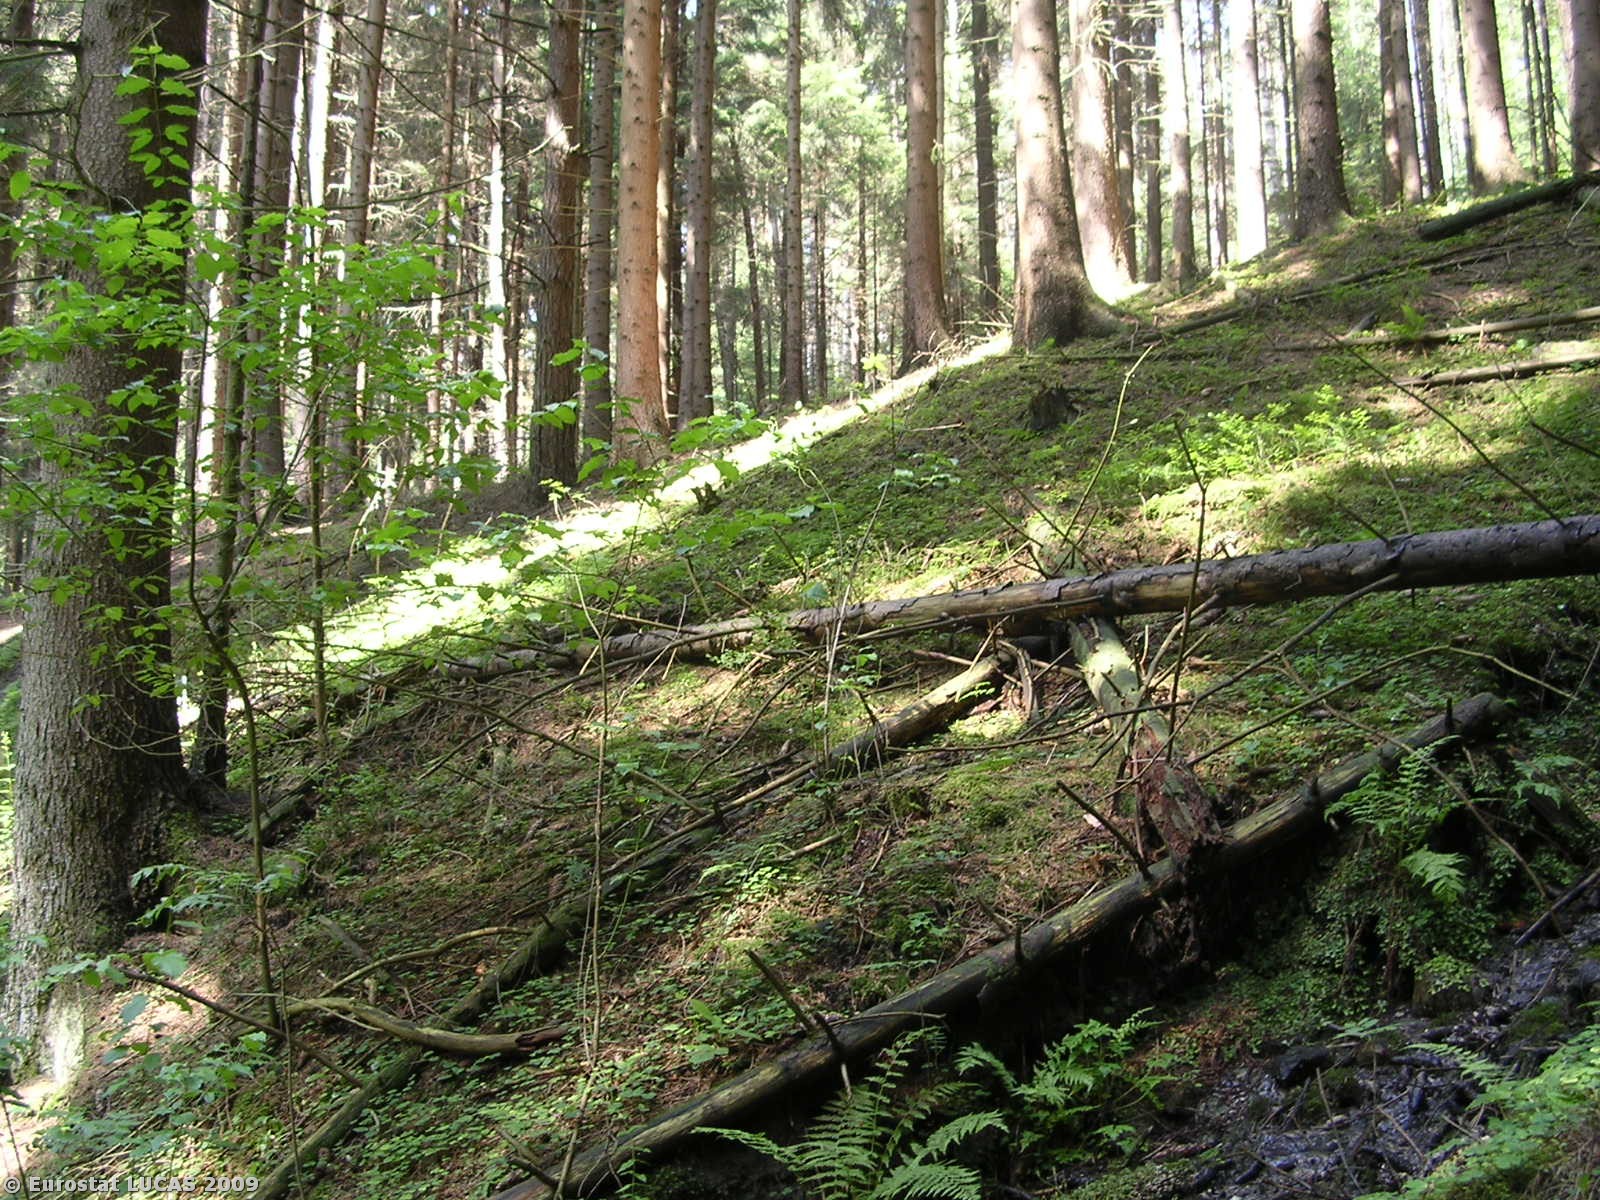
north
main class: Woodland
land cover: Coniferous woodland
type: hemiboreal forest and nemoral coniferous forest and mixed broadleaved-coniferous forest
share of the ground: > 75 %
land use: Forestry
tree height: > 5 m
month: July
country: CZ
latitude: 50.6705
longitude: 14.9693
